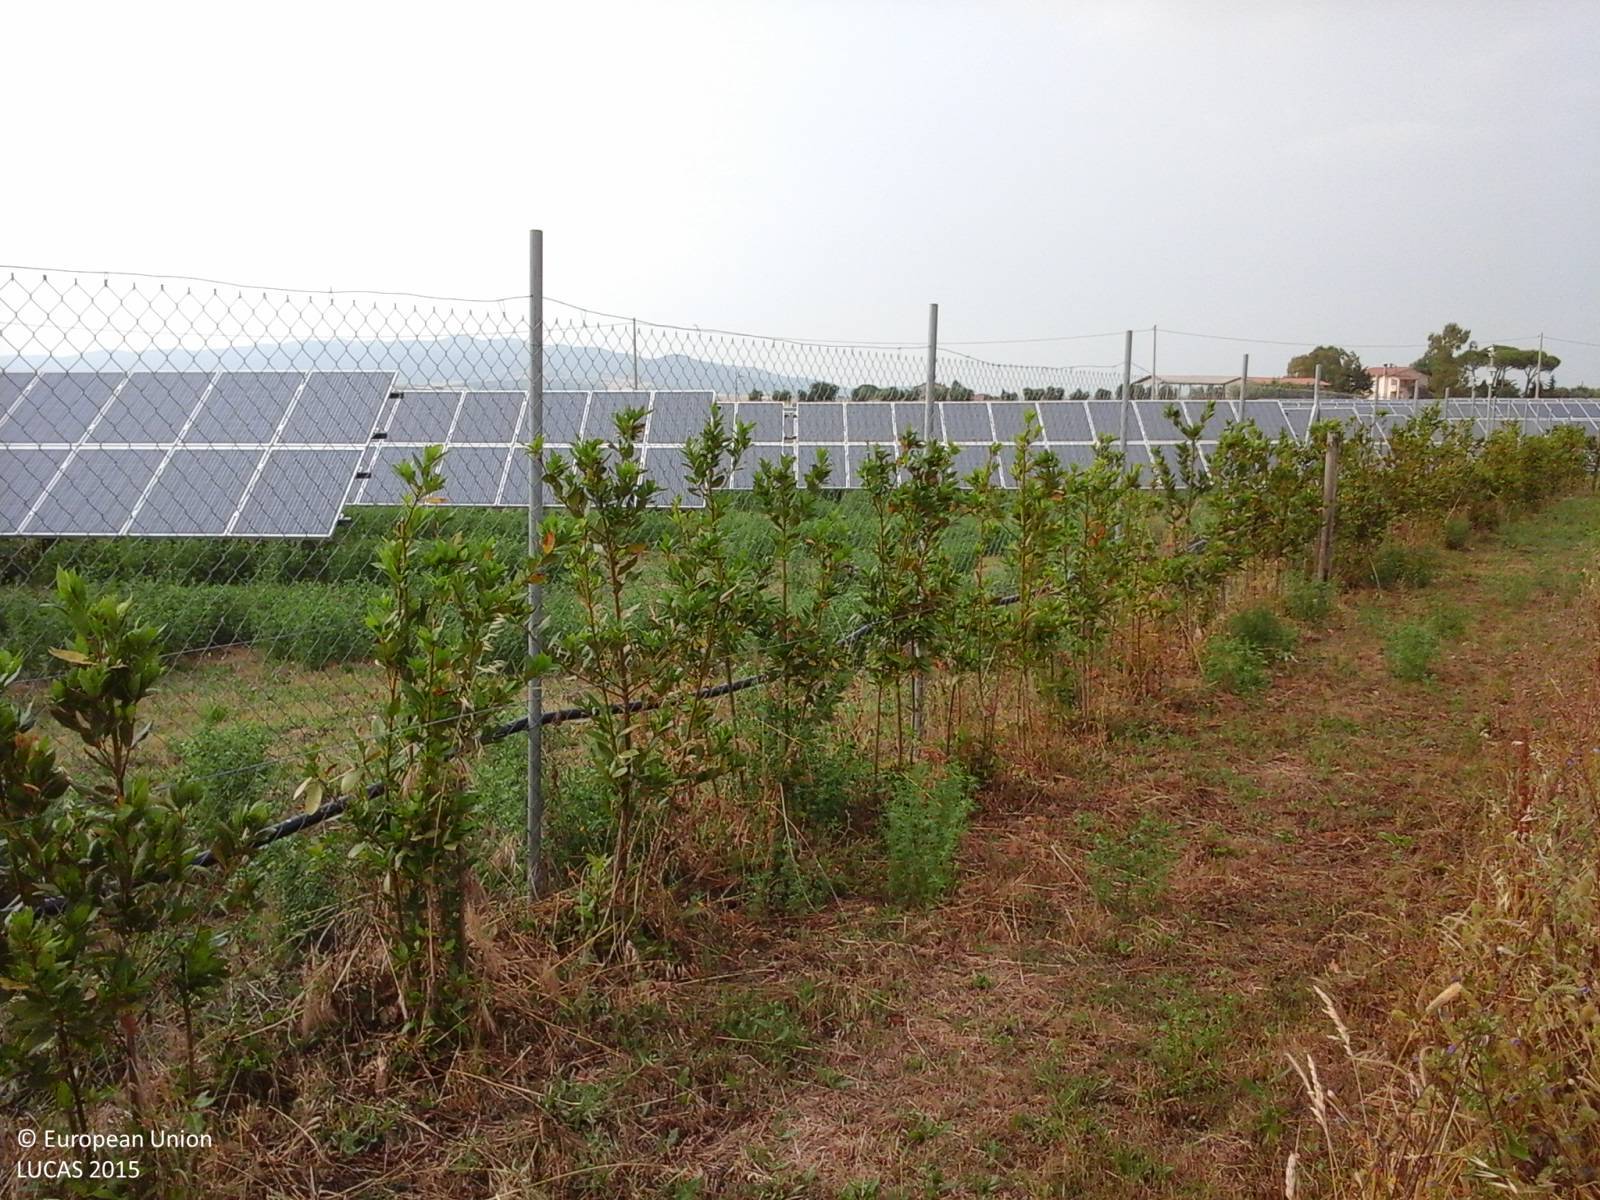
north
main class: Cropland
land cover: Lucerne
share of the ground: > 75 %
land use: Agriculture (excluding fallow land and kitchen gardens)
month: June
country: IT
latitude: 42.4064
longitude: 11.6104
